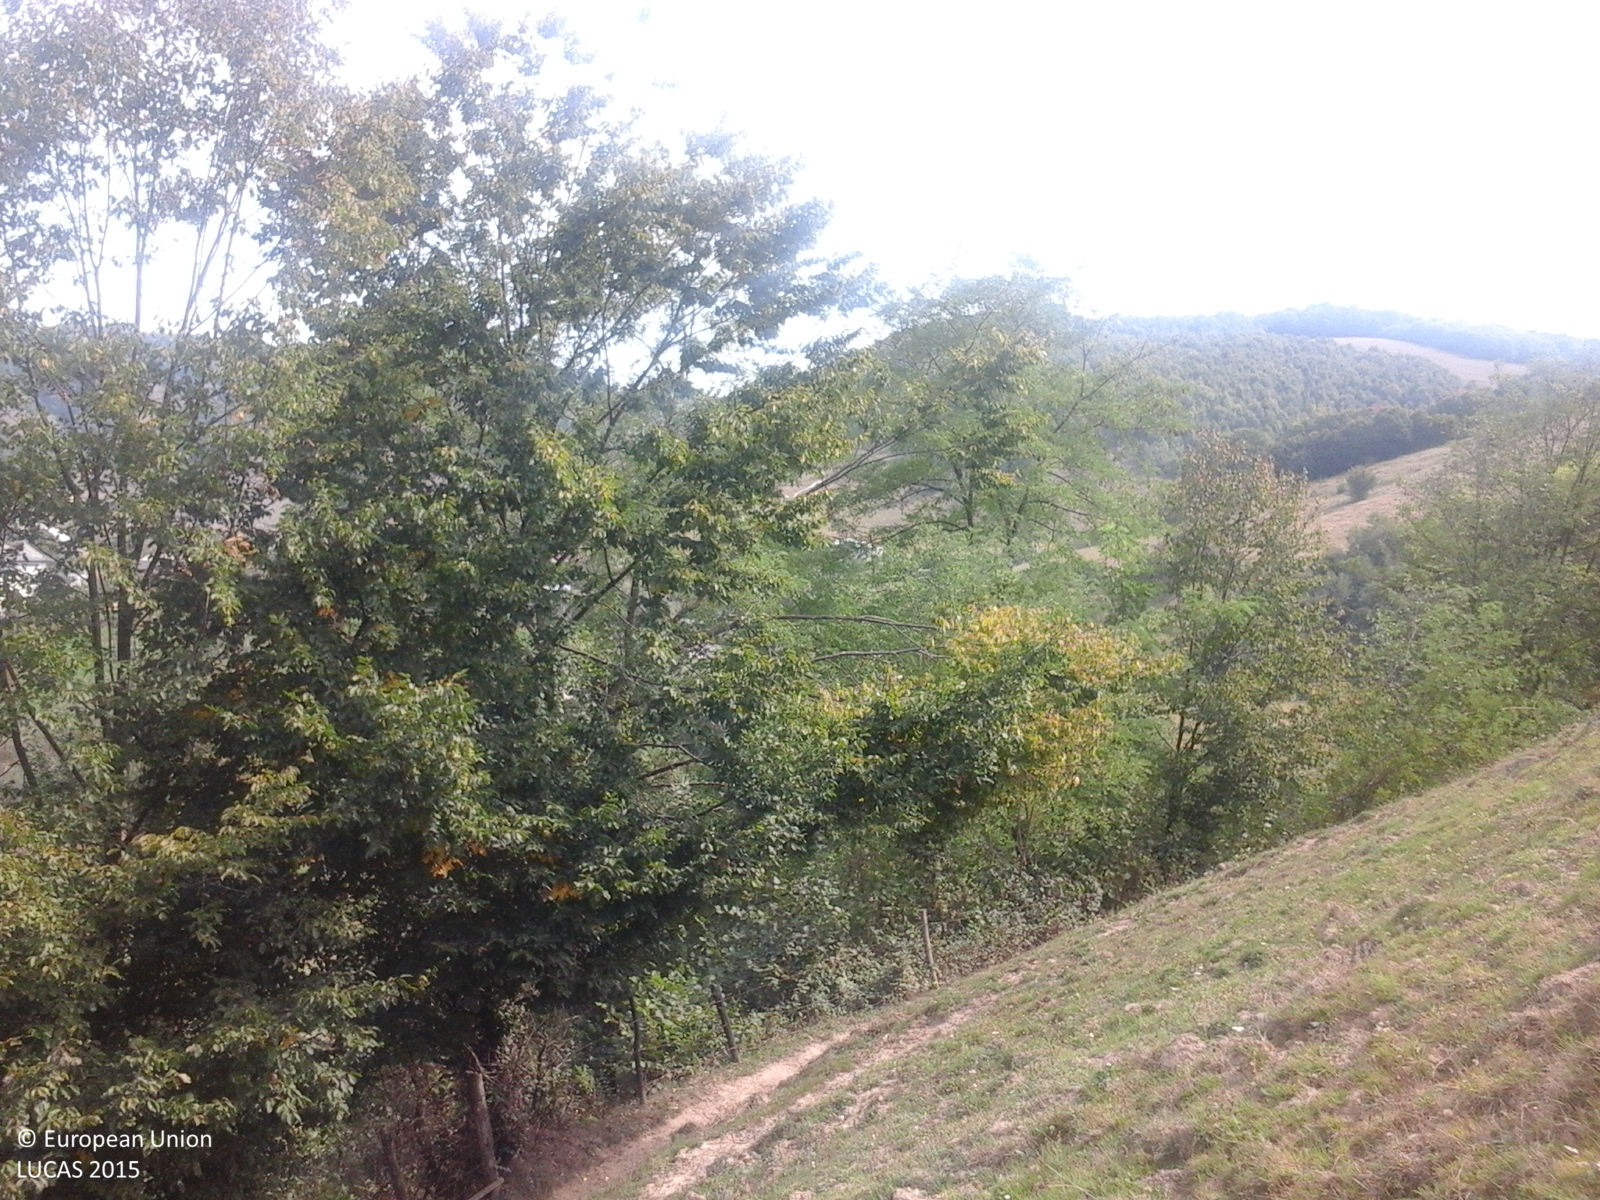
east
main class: Grassland
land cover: Grassland without tree/shrub cover
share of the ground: > 75 %
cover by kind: herbaceous plants 100 %
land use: Agriculture (excluding fallow land and kitchen gardens)
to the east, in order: Grassland without tree/shrub cover; Tracks; Fences; Broadleaved woodland; Lucerne; Lines of trees; Maize; Lines of trees; Inland fresh running water; Broadleaved woodland; Fences; Maize; Clovers; Fences; Grass margins; Tracks; Grass margins; Fences; Lines of trees; Lucerne; Electric lines; Lucerne; Fences; Grassland without tree/shrub cover; Fences; Grassland without tree/shrub cover
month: September
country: RO
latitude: 47.3972
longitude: 24.1431
